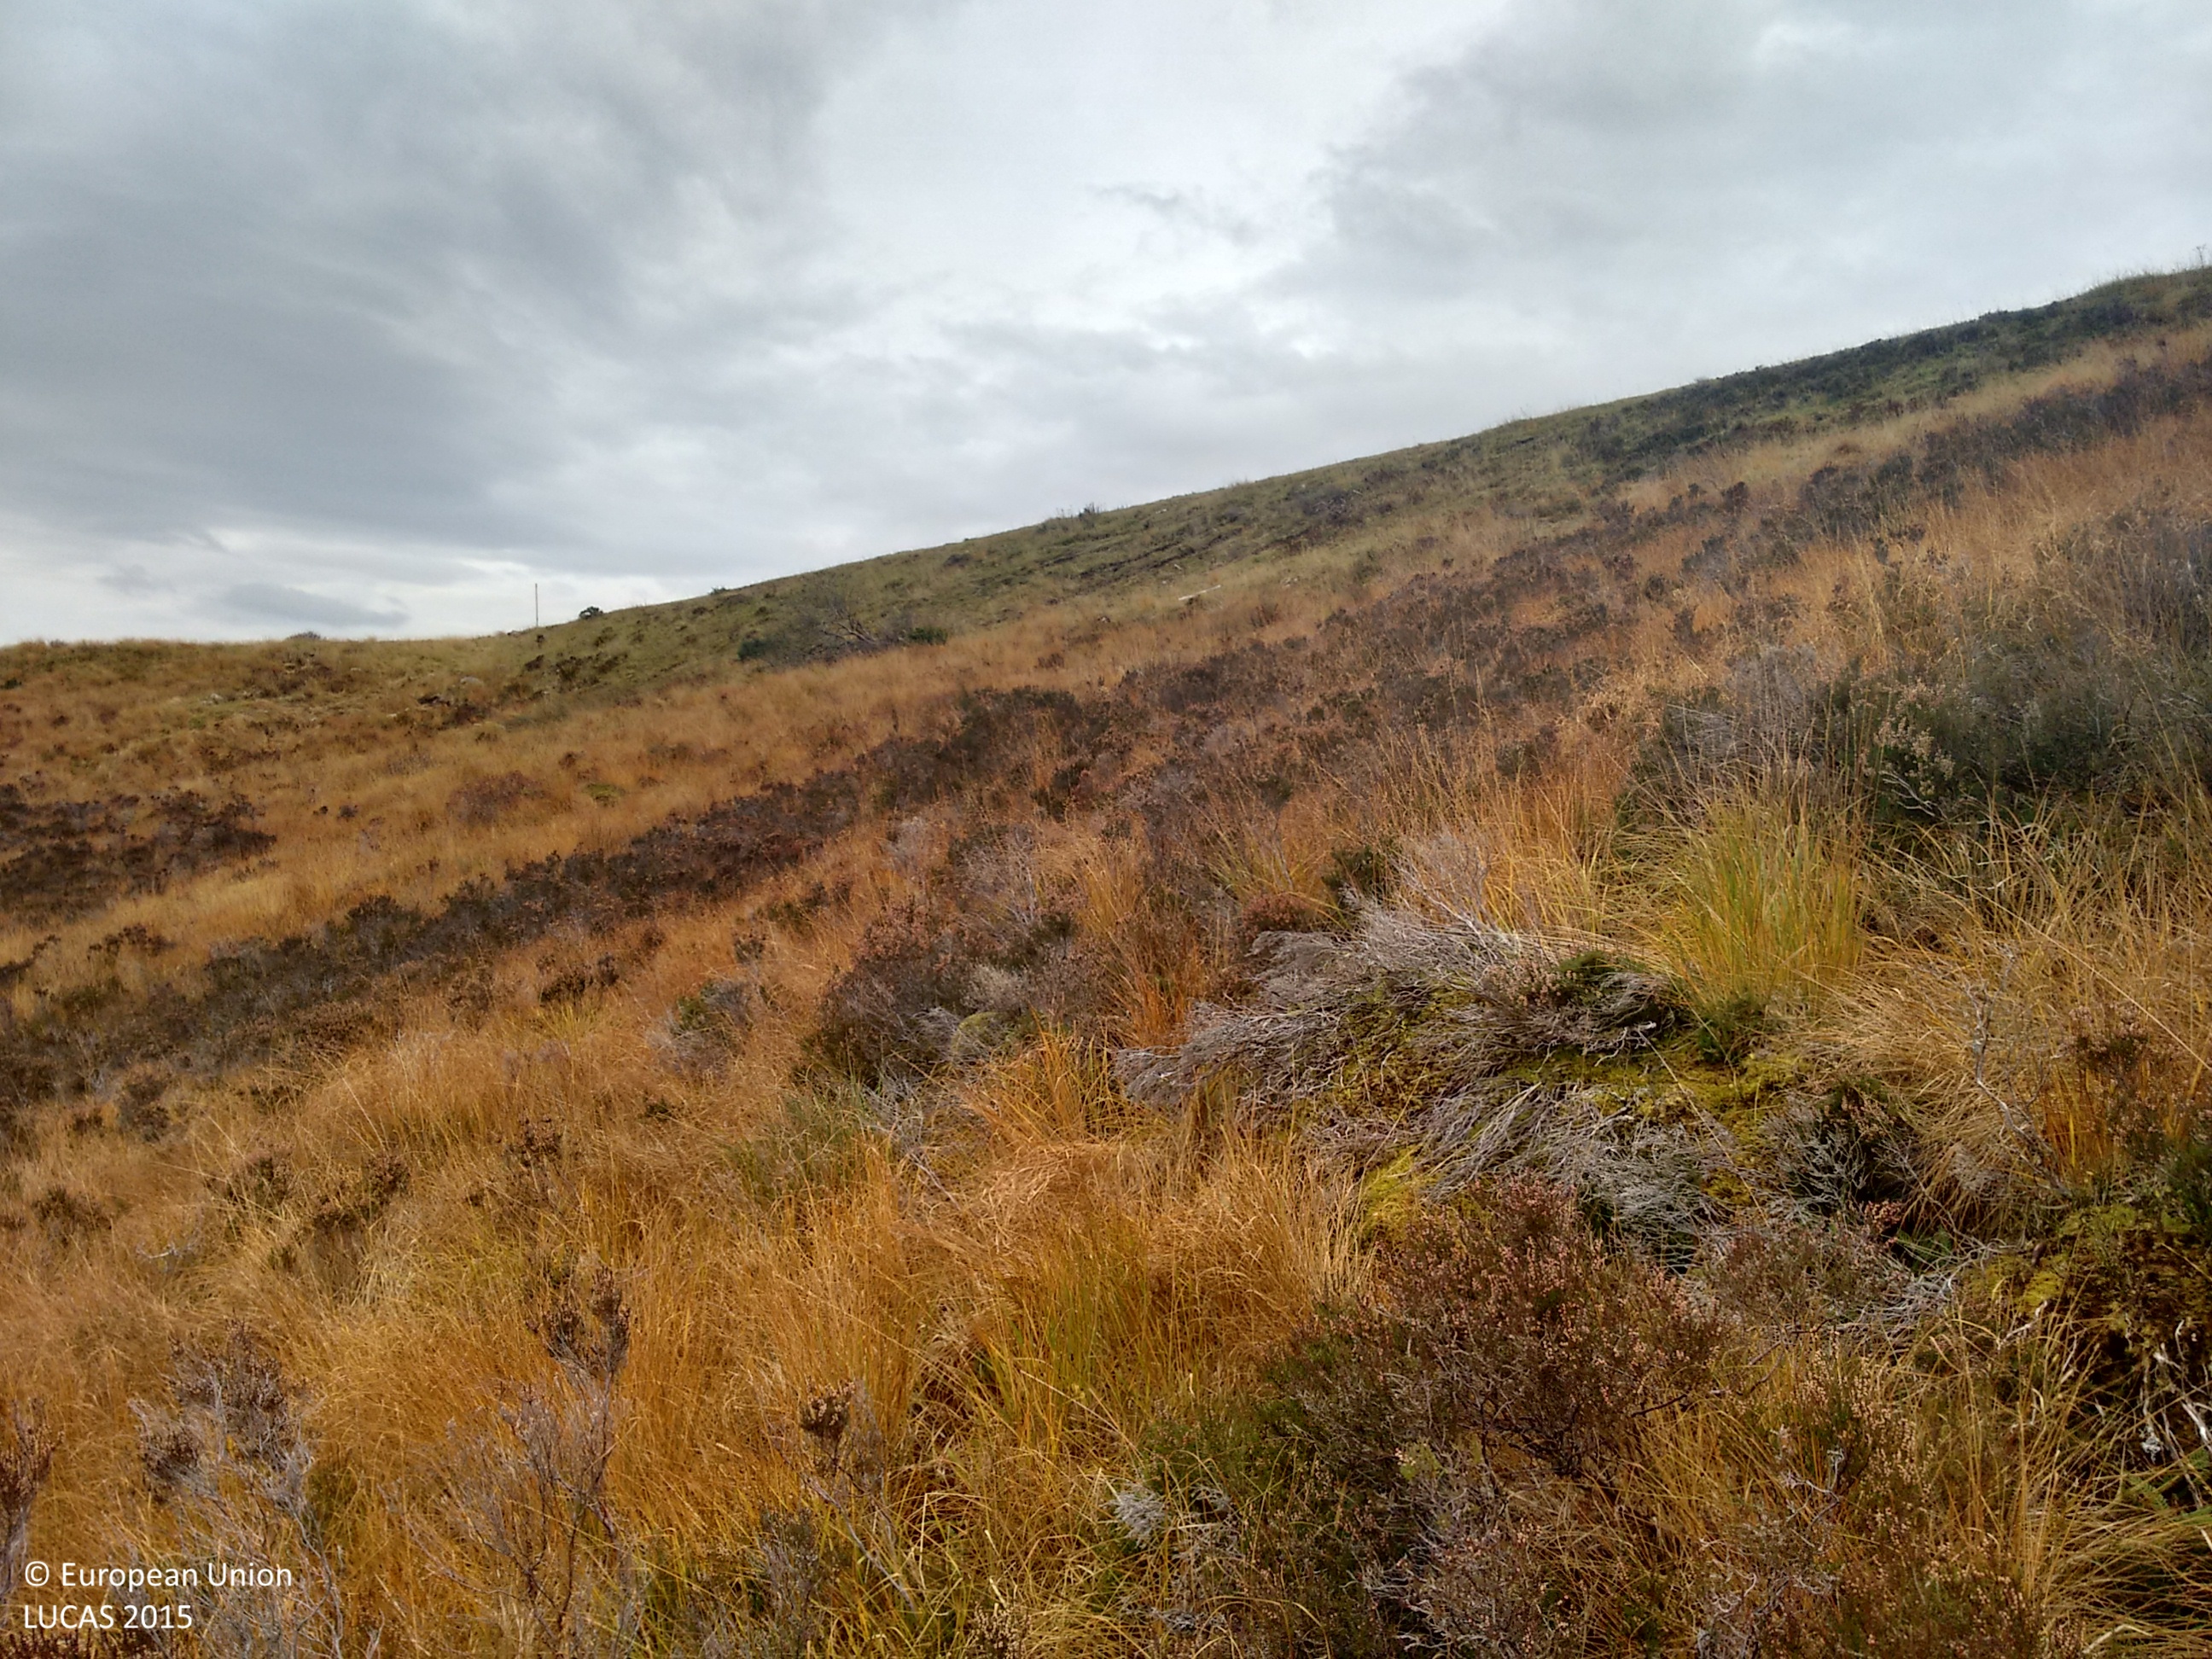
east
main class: Shrubland
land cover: Shrubland without tree cover
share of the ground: > 75 %
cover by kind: shrubs 70 %, herbaceous plants 20 %, lichens and mosses 10 %
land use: Agriculture (excluding fallow land and kitchen gardens)
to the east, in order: Shrubland without tree cover; Grass margins; Paved roads, cycling and walking lanes; Grass margins; Ditches and canals; Peatbogs; Fences; Peatbogs
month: November
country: GB
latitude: 57.1157
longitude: -4.9834
